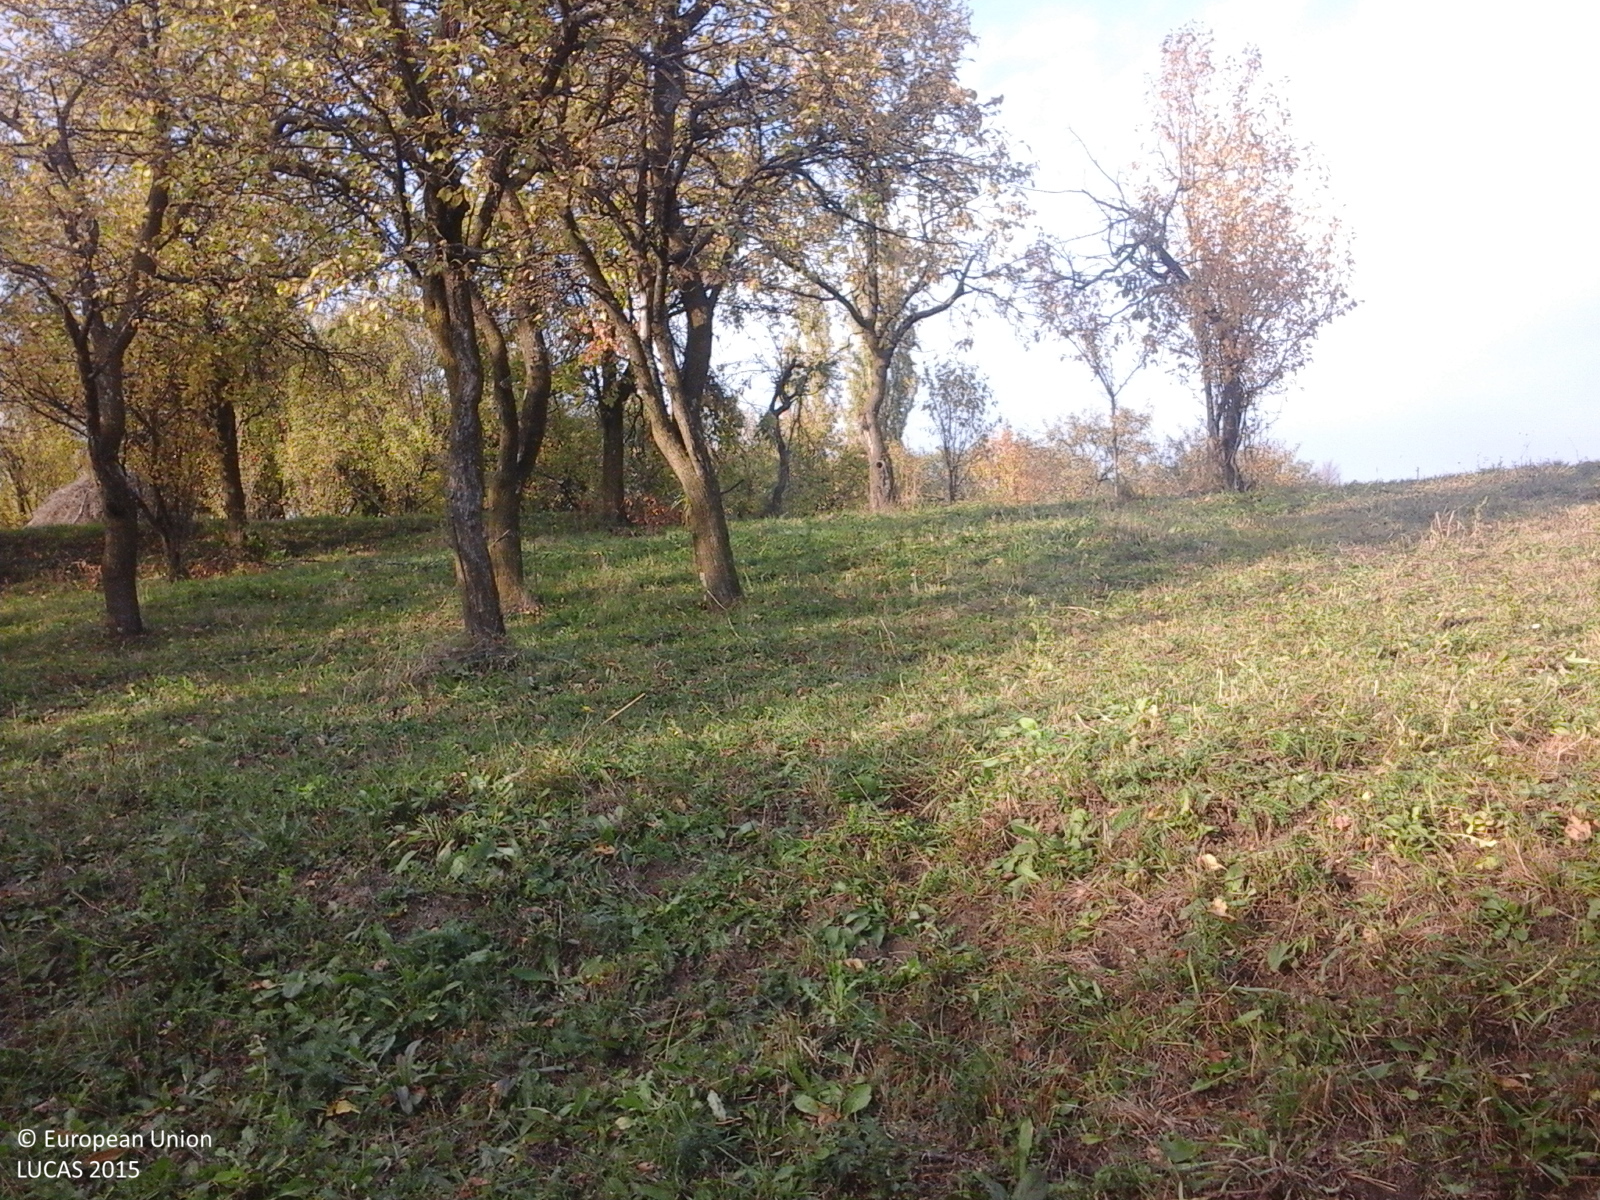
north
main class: Cropland
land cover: Other fruit trees and berries
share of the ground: > 75 %
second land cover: Grassland without tree/shrub cover
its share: > 75 %
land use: Agriculture (excluding fallow land and kitchen gardens)
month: October
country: RO
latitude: 45.5089
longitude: 26.7856
